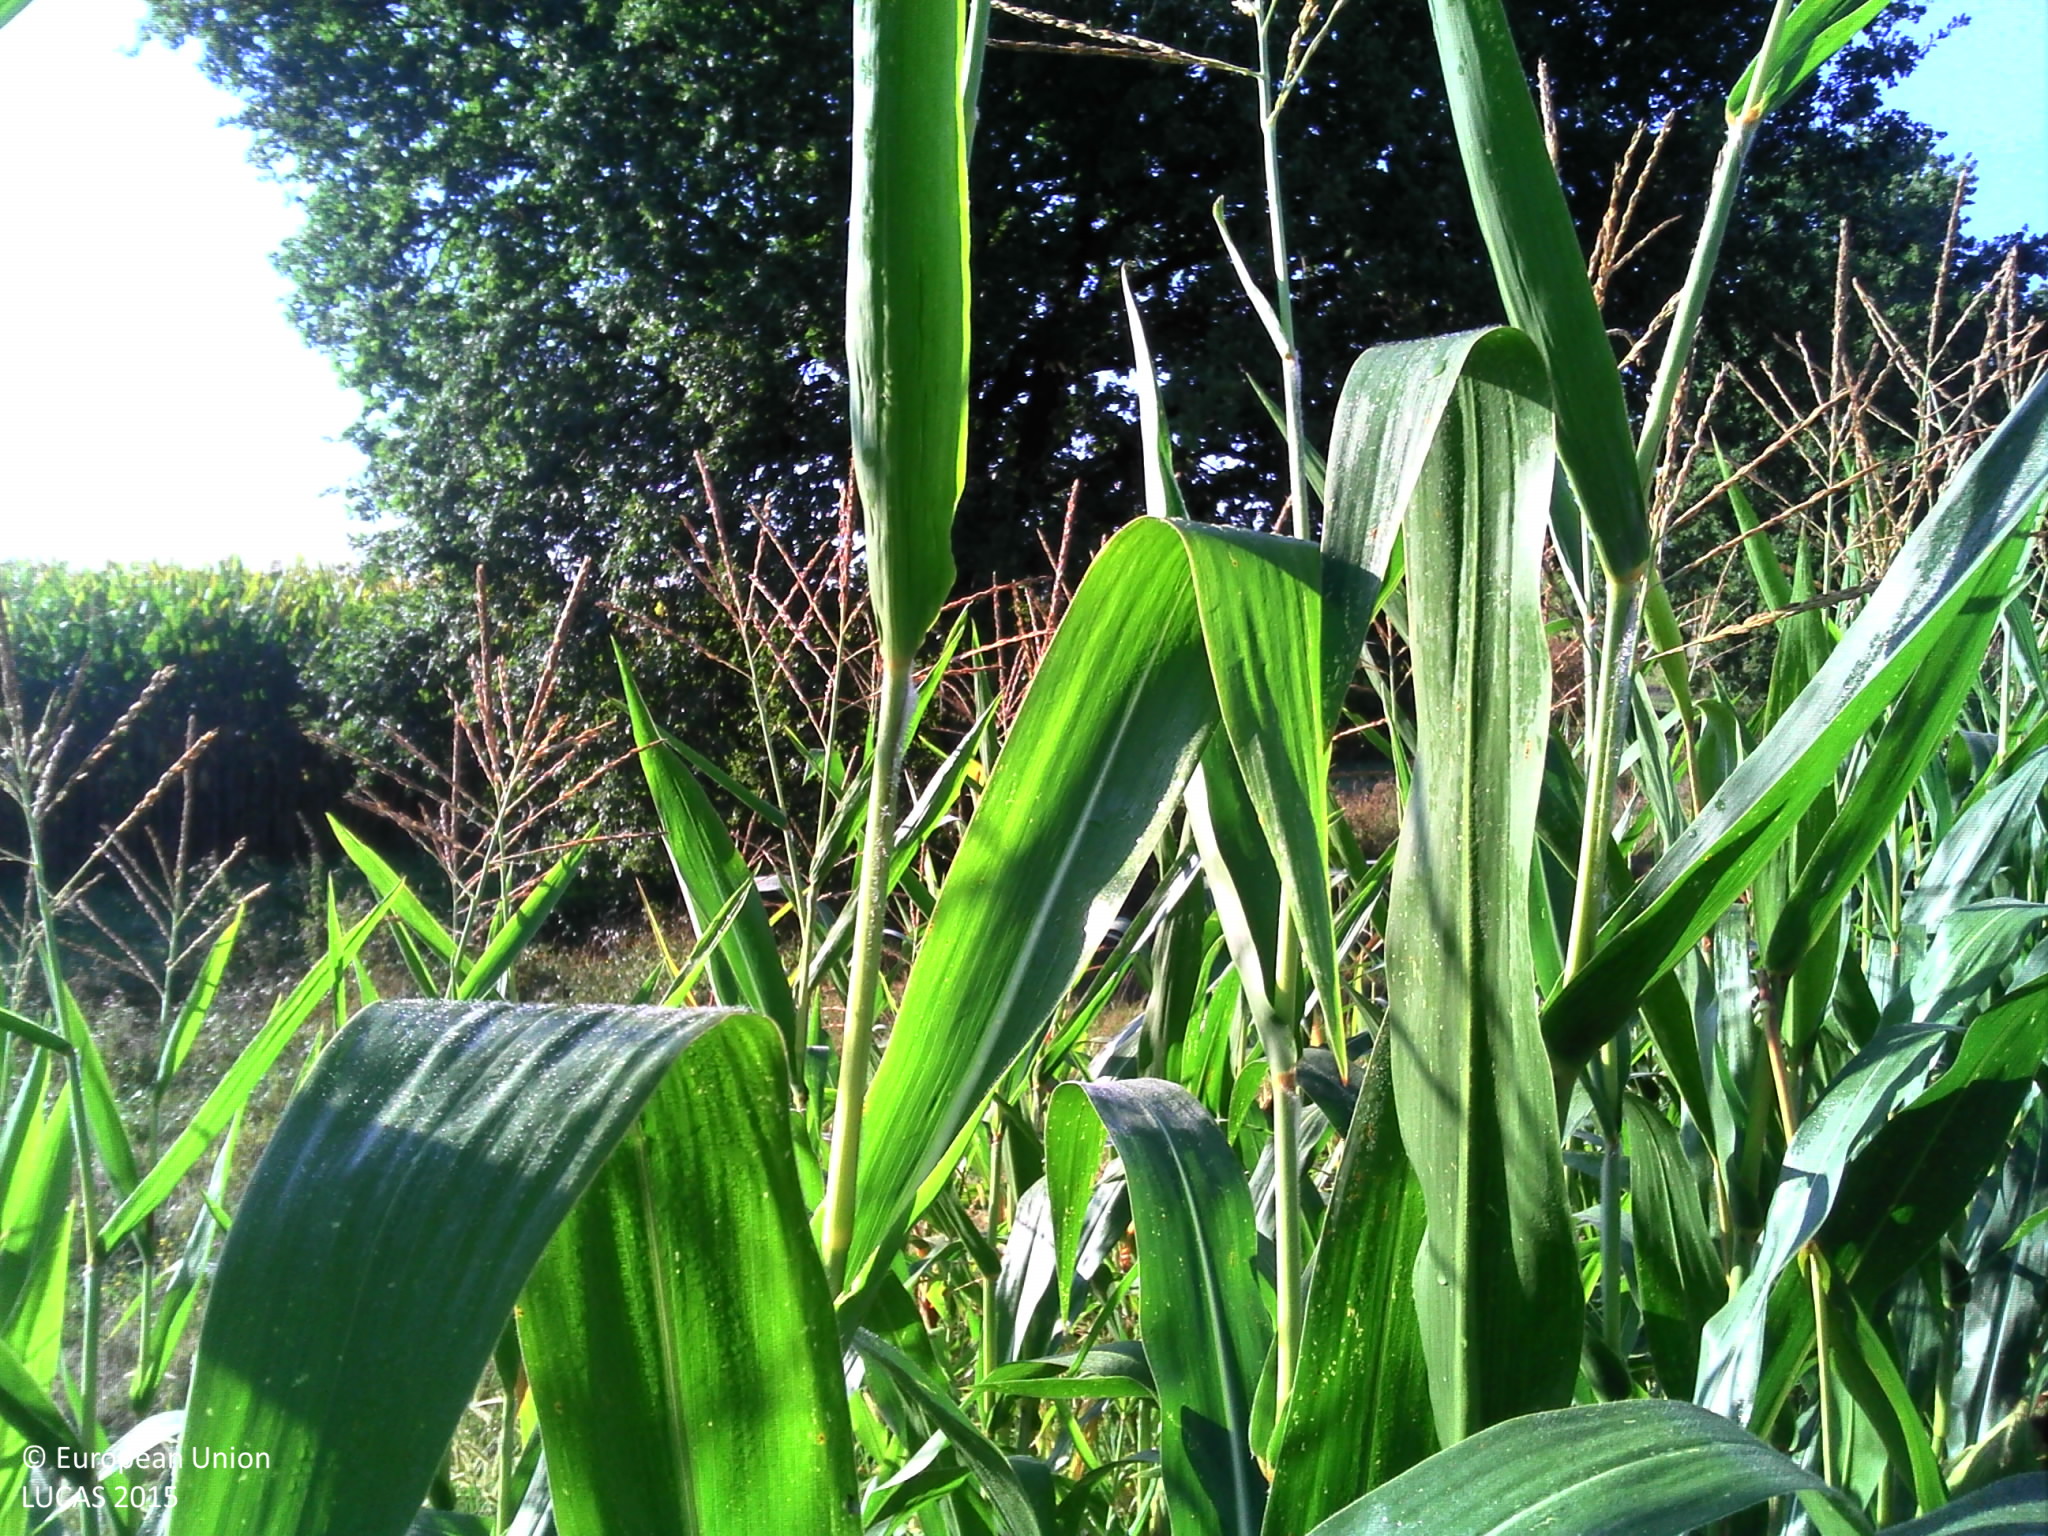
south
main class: Cropland
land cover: Maize
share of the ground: > 75 %
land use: Agriculture (excluding fallow land and kitchen gardens)
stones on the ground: 10 - 25 %
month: September
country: FR
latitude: 43.5242
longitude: -0.6884
